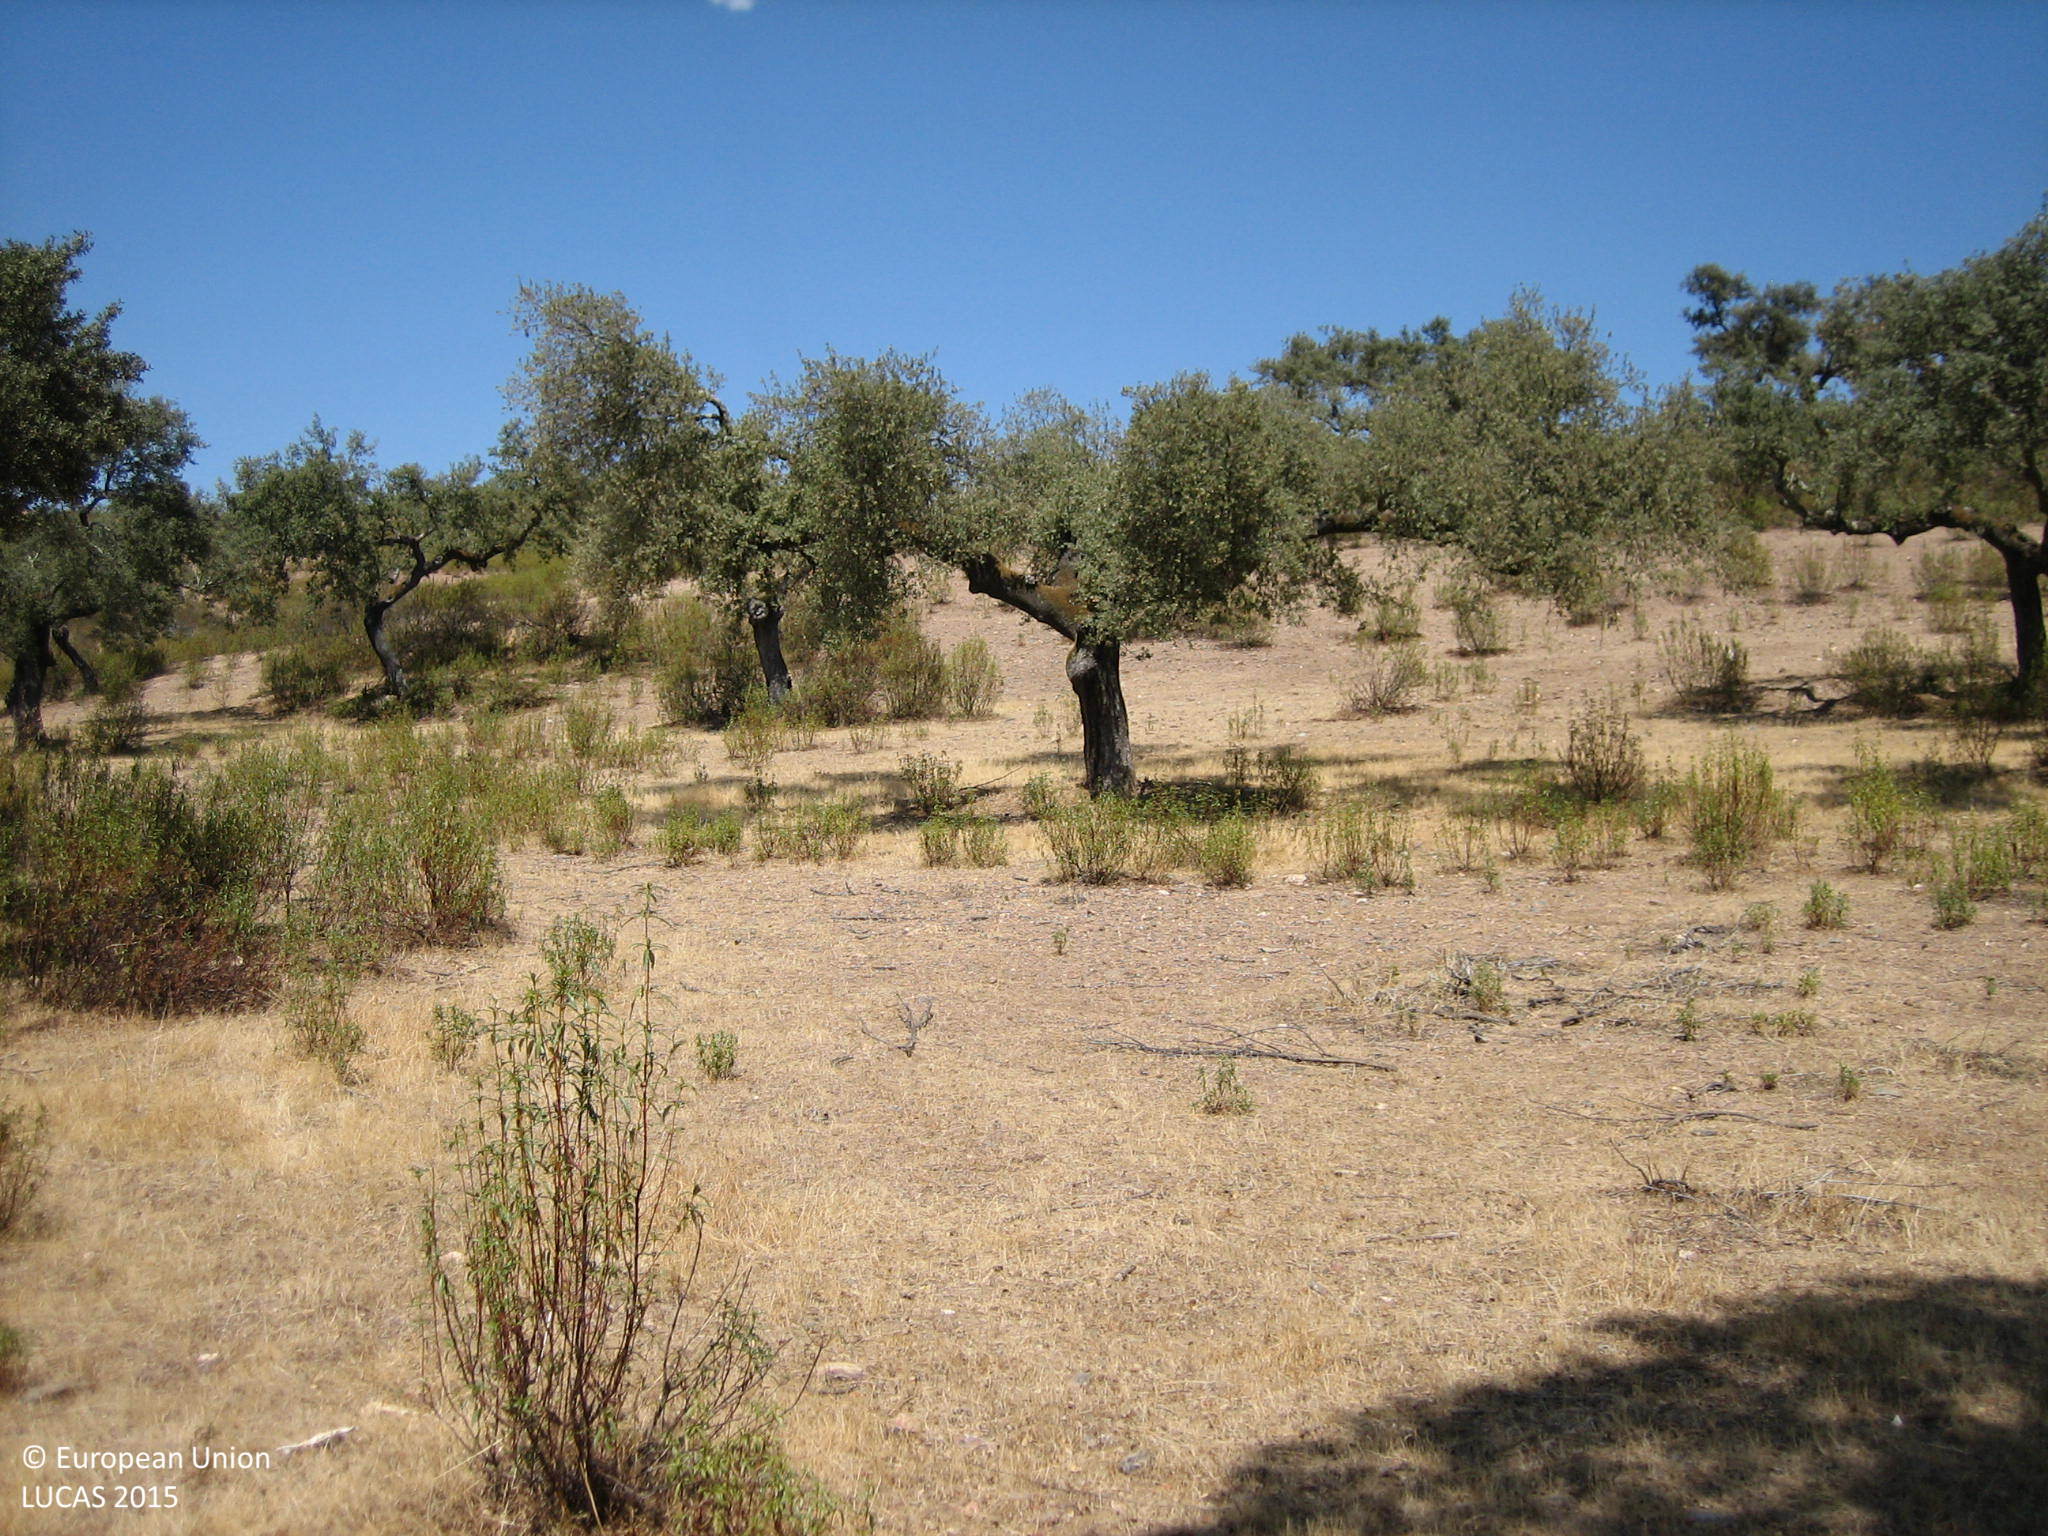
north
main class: Woodland
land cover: Broadleaved woodland
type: broadleaved evergreen forest
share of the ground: 10 - 25 %
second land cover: Grassland without tree/shrub cover
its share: 50 - 75 %
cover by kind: herbaceous plants 50 %, unconsolidated bare surface 25 %, broadleaved forest trees 20 %, shrubs 5 %
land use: Forestry
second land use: Agriculture (excluding fallow land and kitchen gardens)
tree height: > 5 m
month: September
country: ES
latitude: 38.2159
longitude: -7.1129
